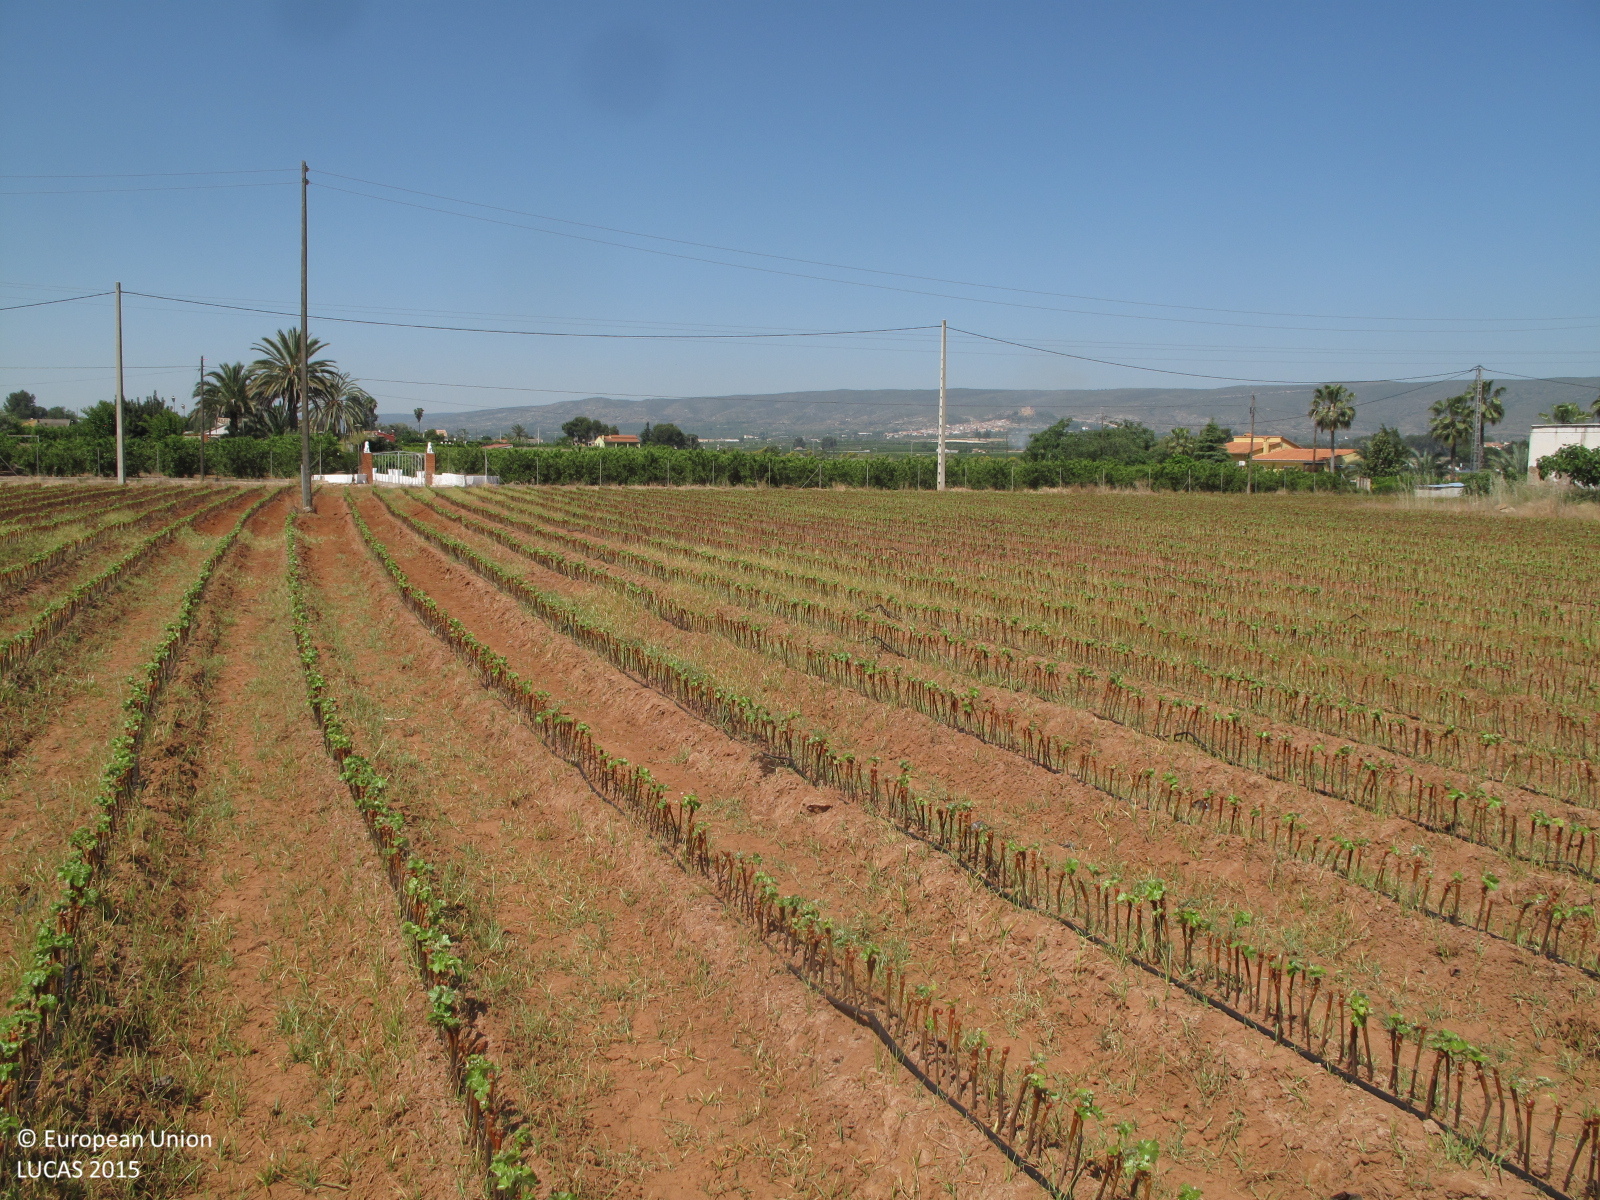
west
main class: Cropland
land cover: Vineyards
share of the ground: 10 - 25 %
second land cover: Spontaneously vegetated surfaces
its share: 10 - 25 %
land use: Agriculture (excluding fallow land and kitchen gardens)
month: May
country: ES
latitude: 38.9439
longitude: -0.5956
